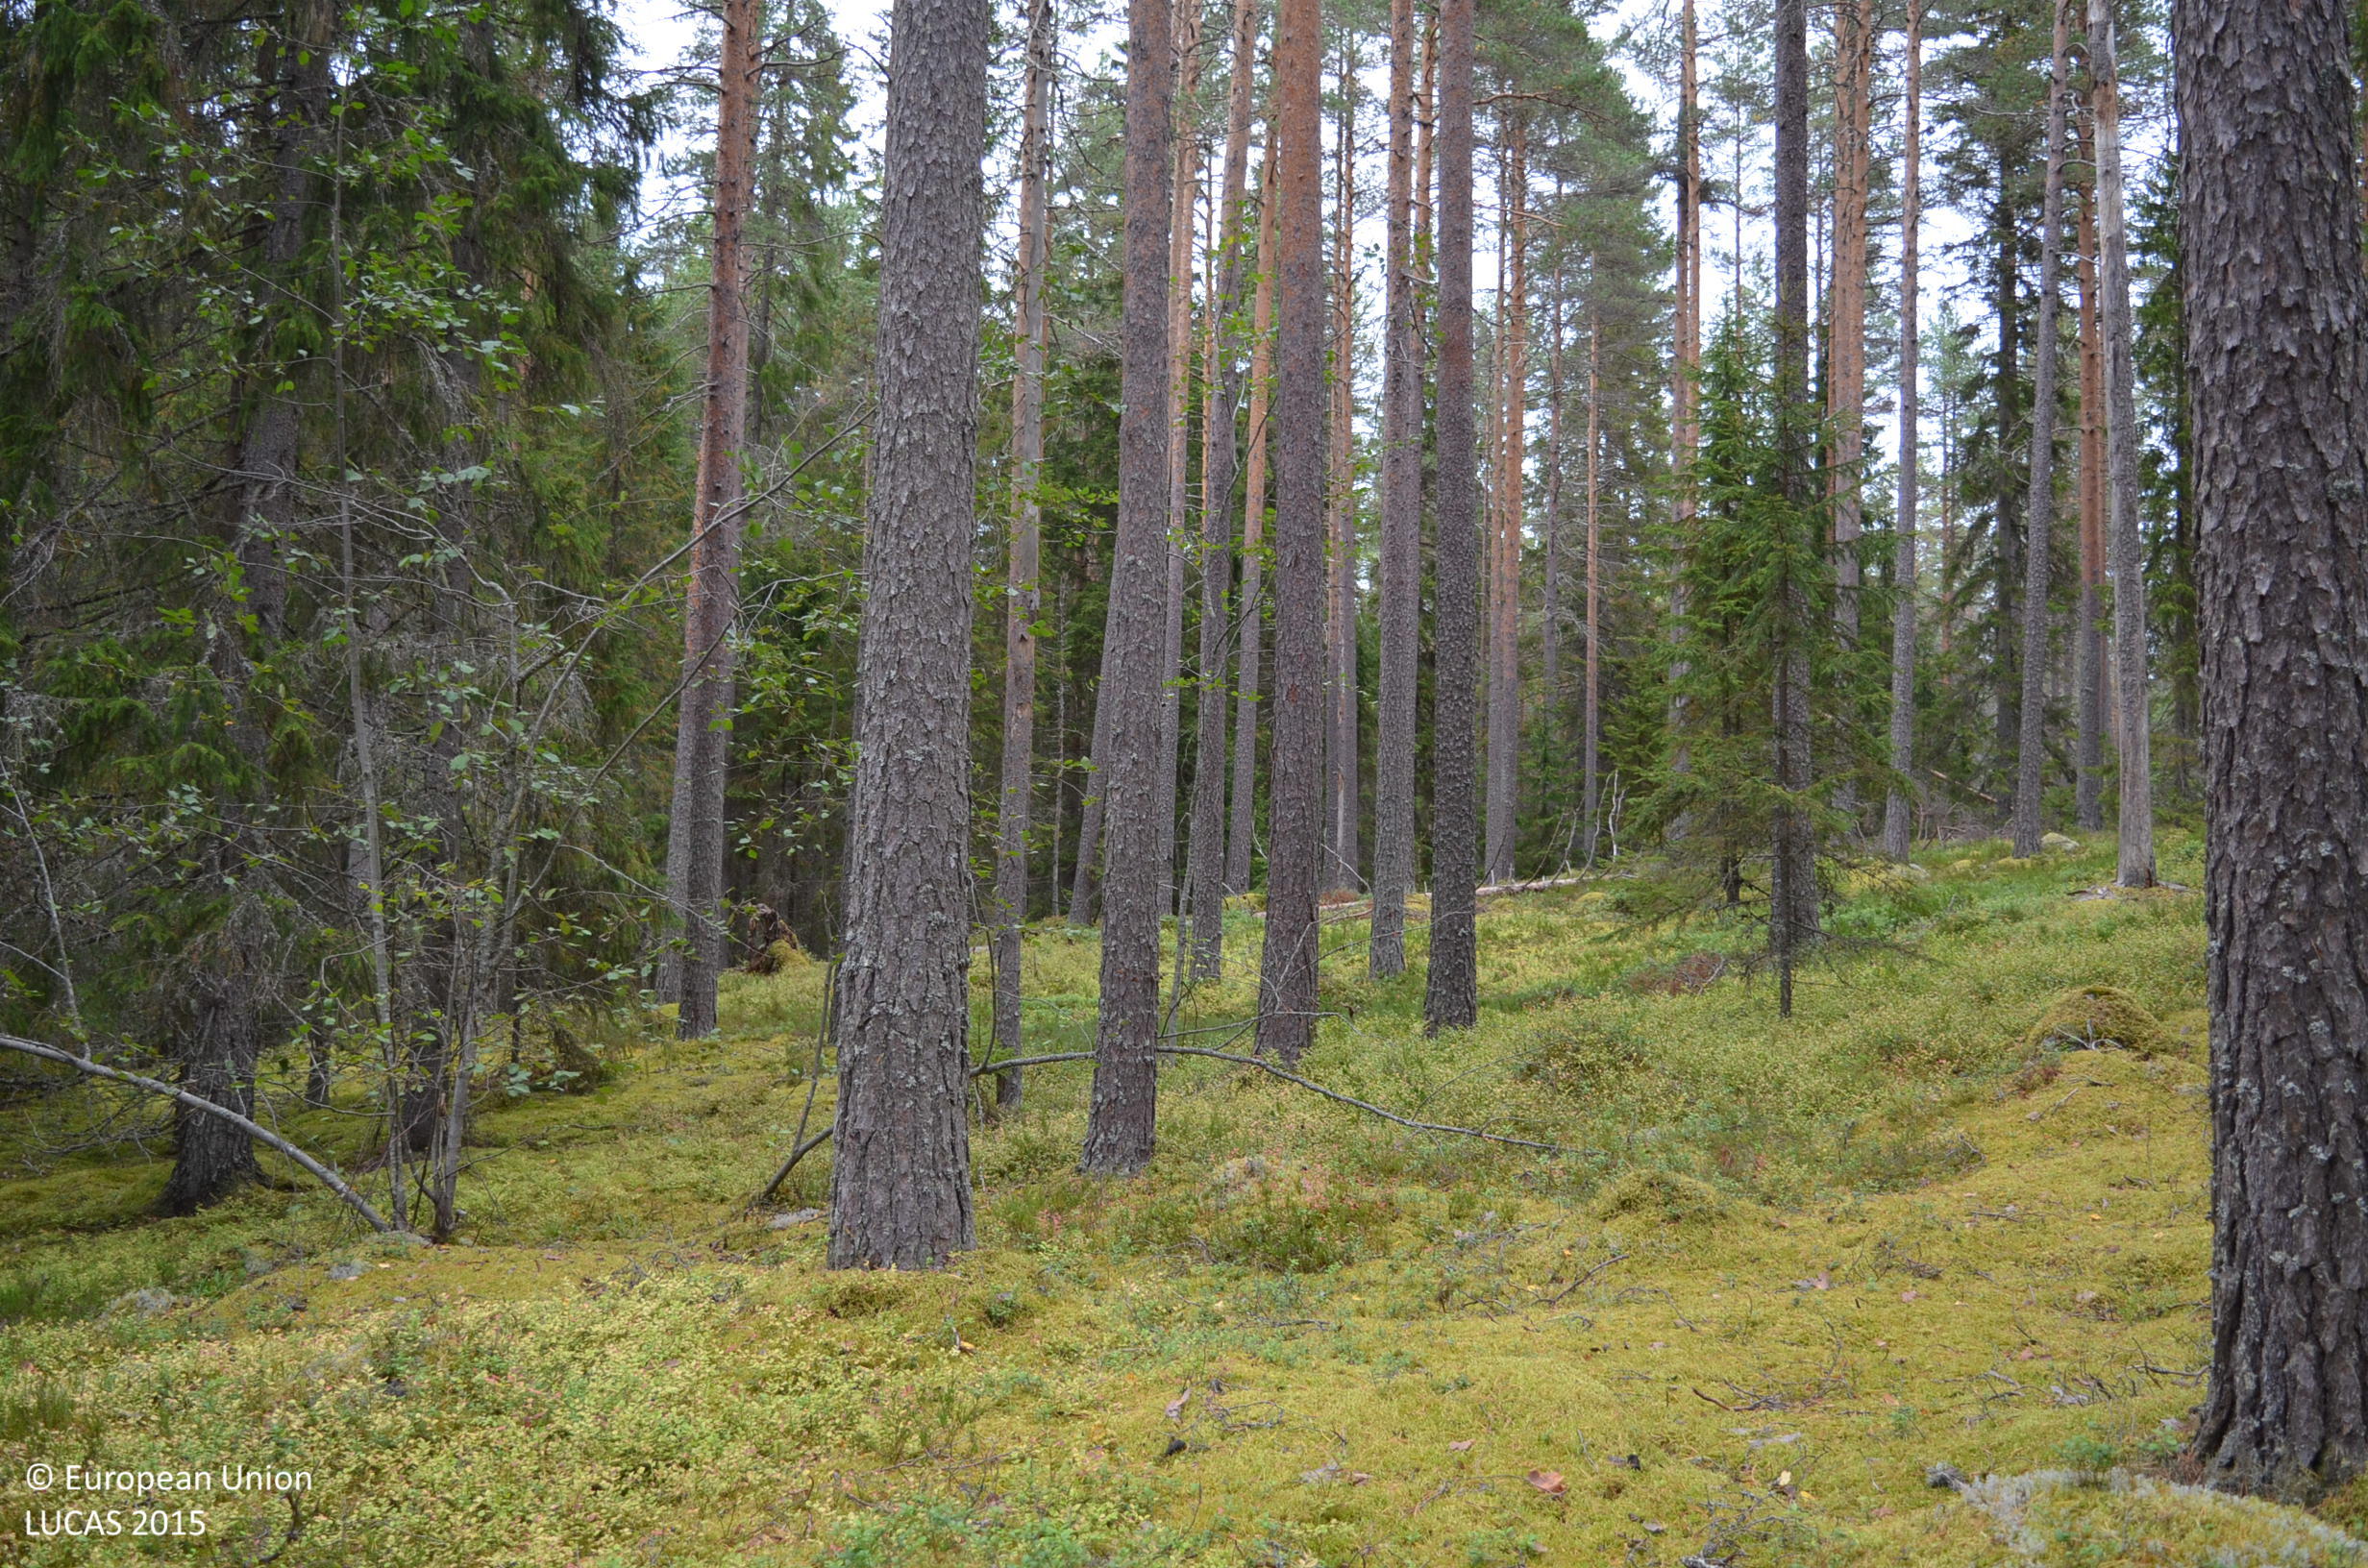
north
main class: Woodland
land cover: Other coniferous woodland
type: boreal forest
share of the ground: 50 - 75 %
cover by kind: coniferous forest trees 70 %, shrubs 15 %, lichens and mosses 15 %
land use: Forestry
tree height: > 5 m
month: September
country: FI
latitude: 62.8537
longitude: 23.8054
